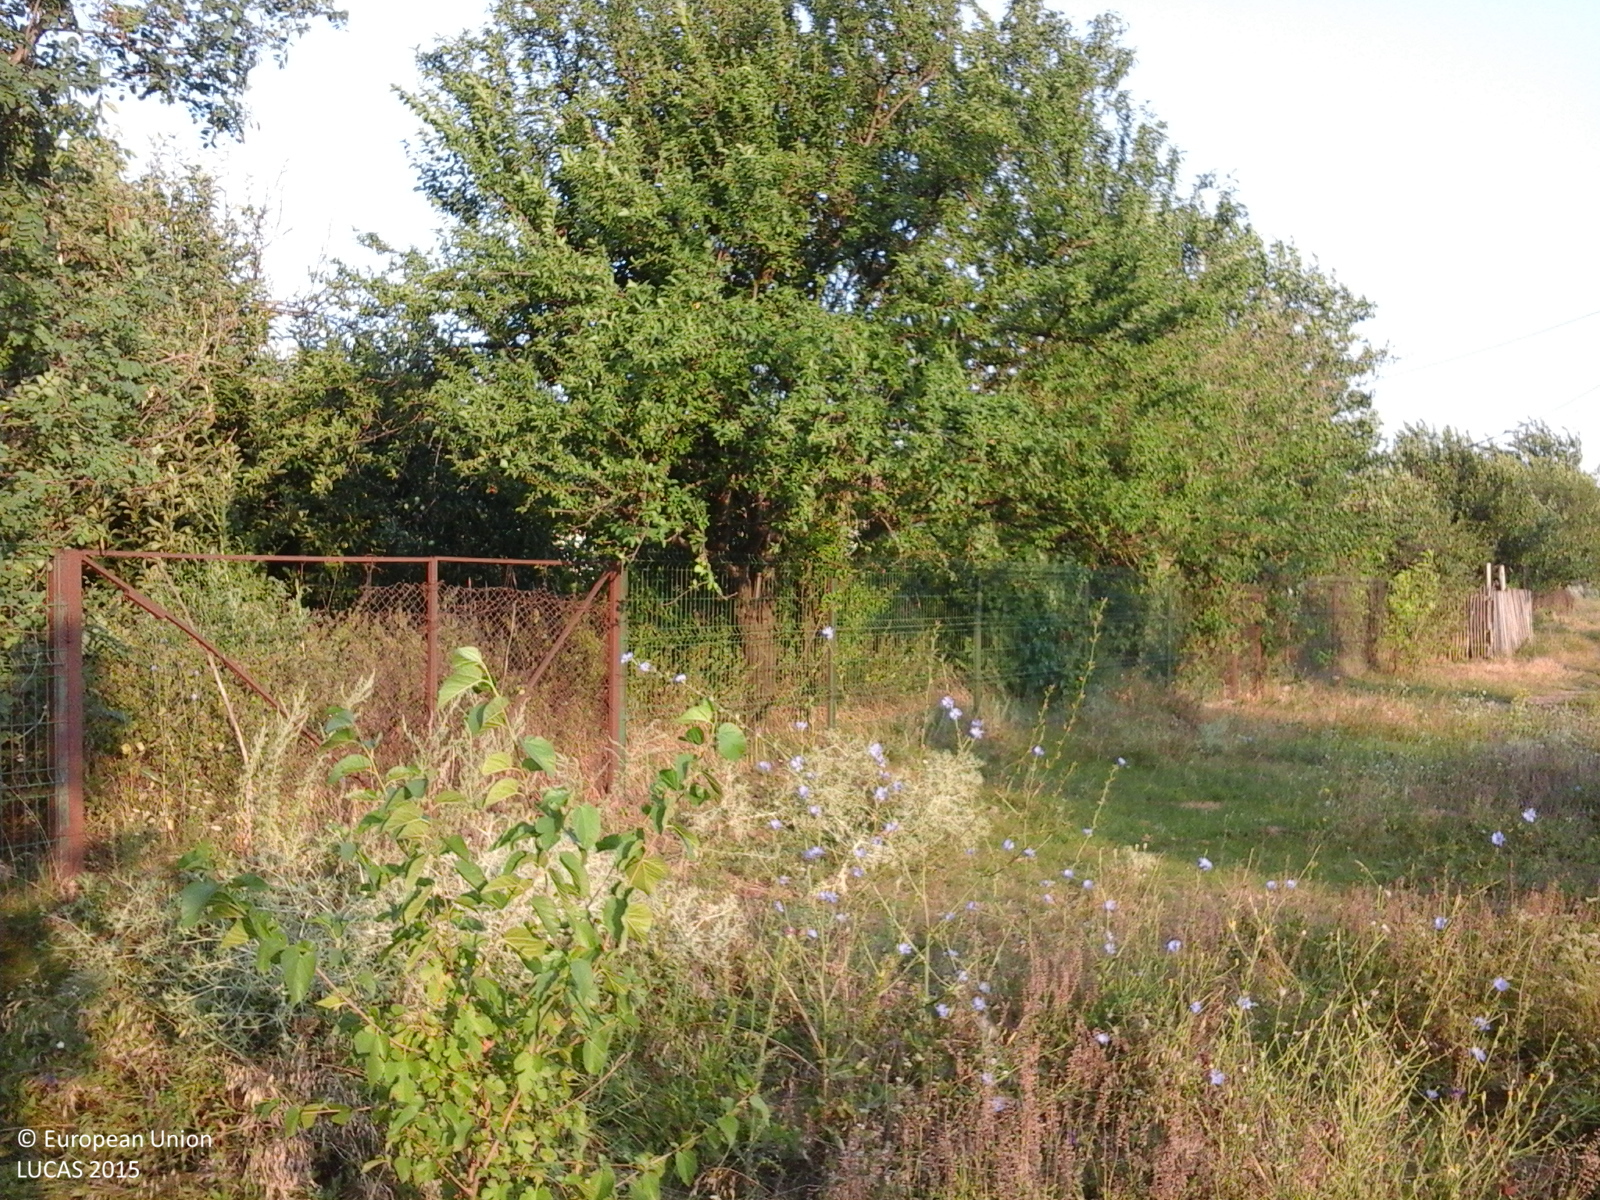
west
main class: Grassland
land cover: Grassland without tree/shrub cover
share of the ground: > 75 %
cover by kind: herbaceous plants 100 %
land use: Agriculture (excluding fallow land and kitchen gardens)
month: July
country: RO
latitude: 44.6011
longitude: 27.0515
